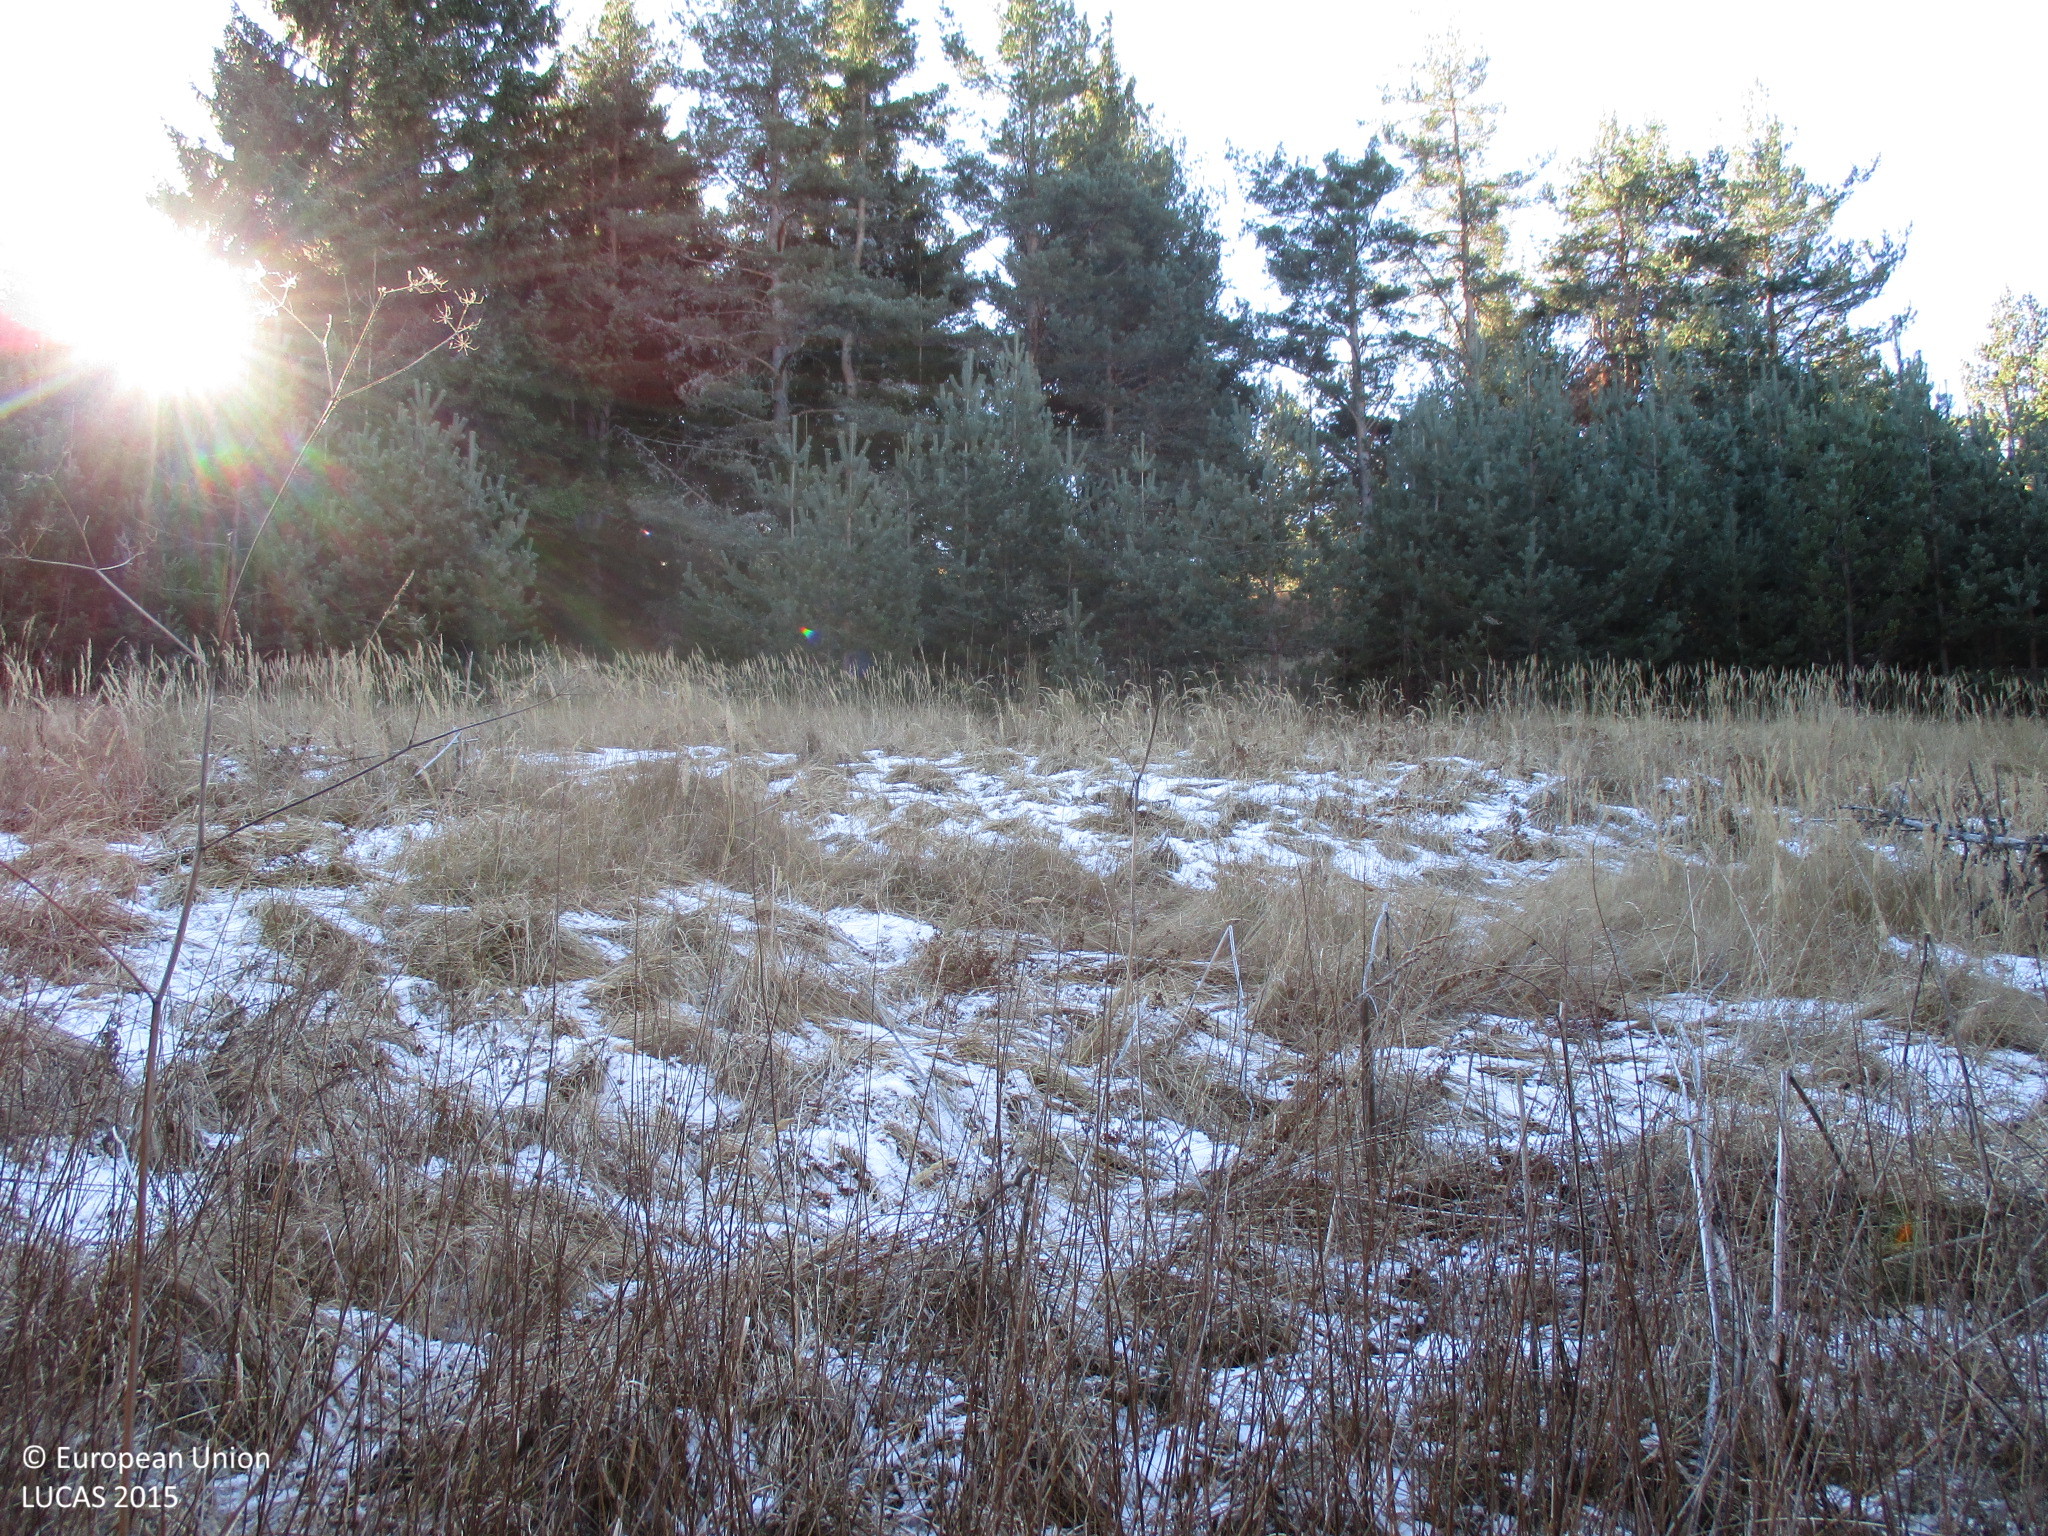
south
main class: Woodland
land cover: Spruce dominated coniferous woodland
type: alpine coniferous forest
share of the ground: > 75 %
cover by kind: coniferous forest trees 100 %
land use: Forestry
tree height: > 5 m
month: December
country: BG
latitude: 41.9195
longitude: 24.5997
